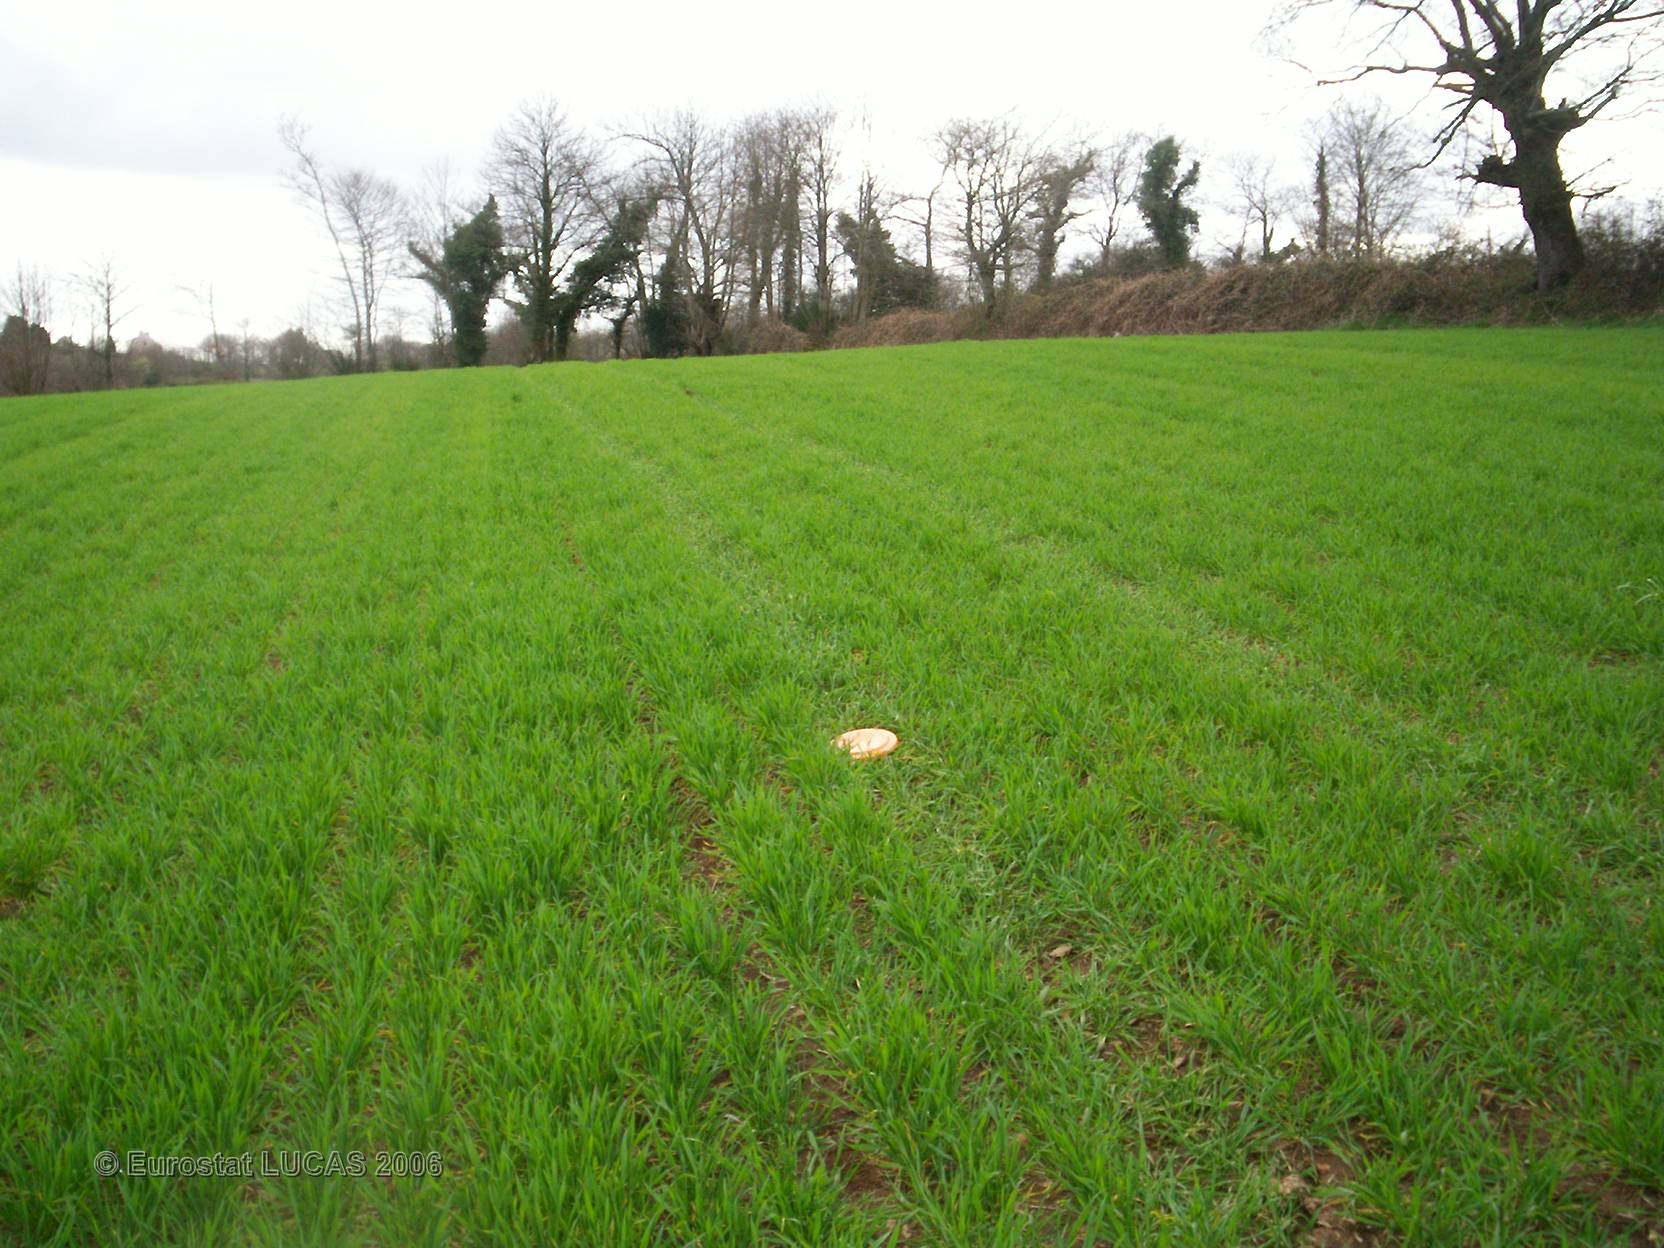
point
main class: Cropland
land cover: Barley
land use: Agriculture (excluding fallow land and kitchen gardens)
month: April
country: FR
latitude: 48.0491
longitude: -3.6150
